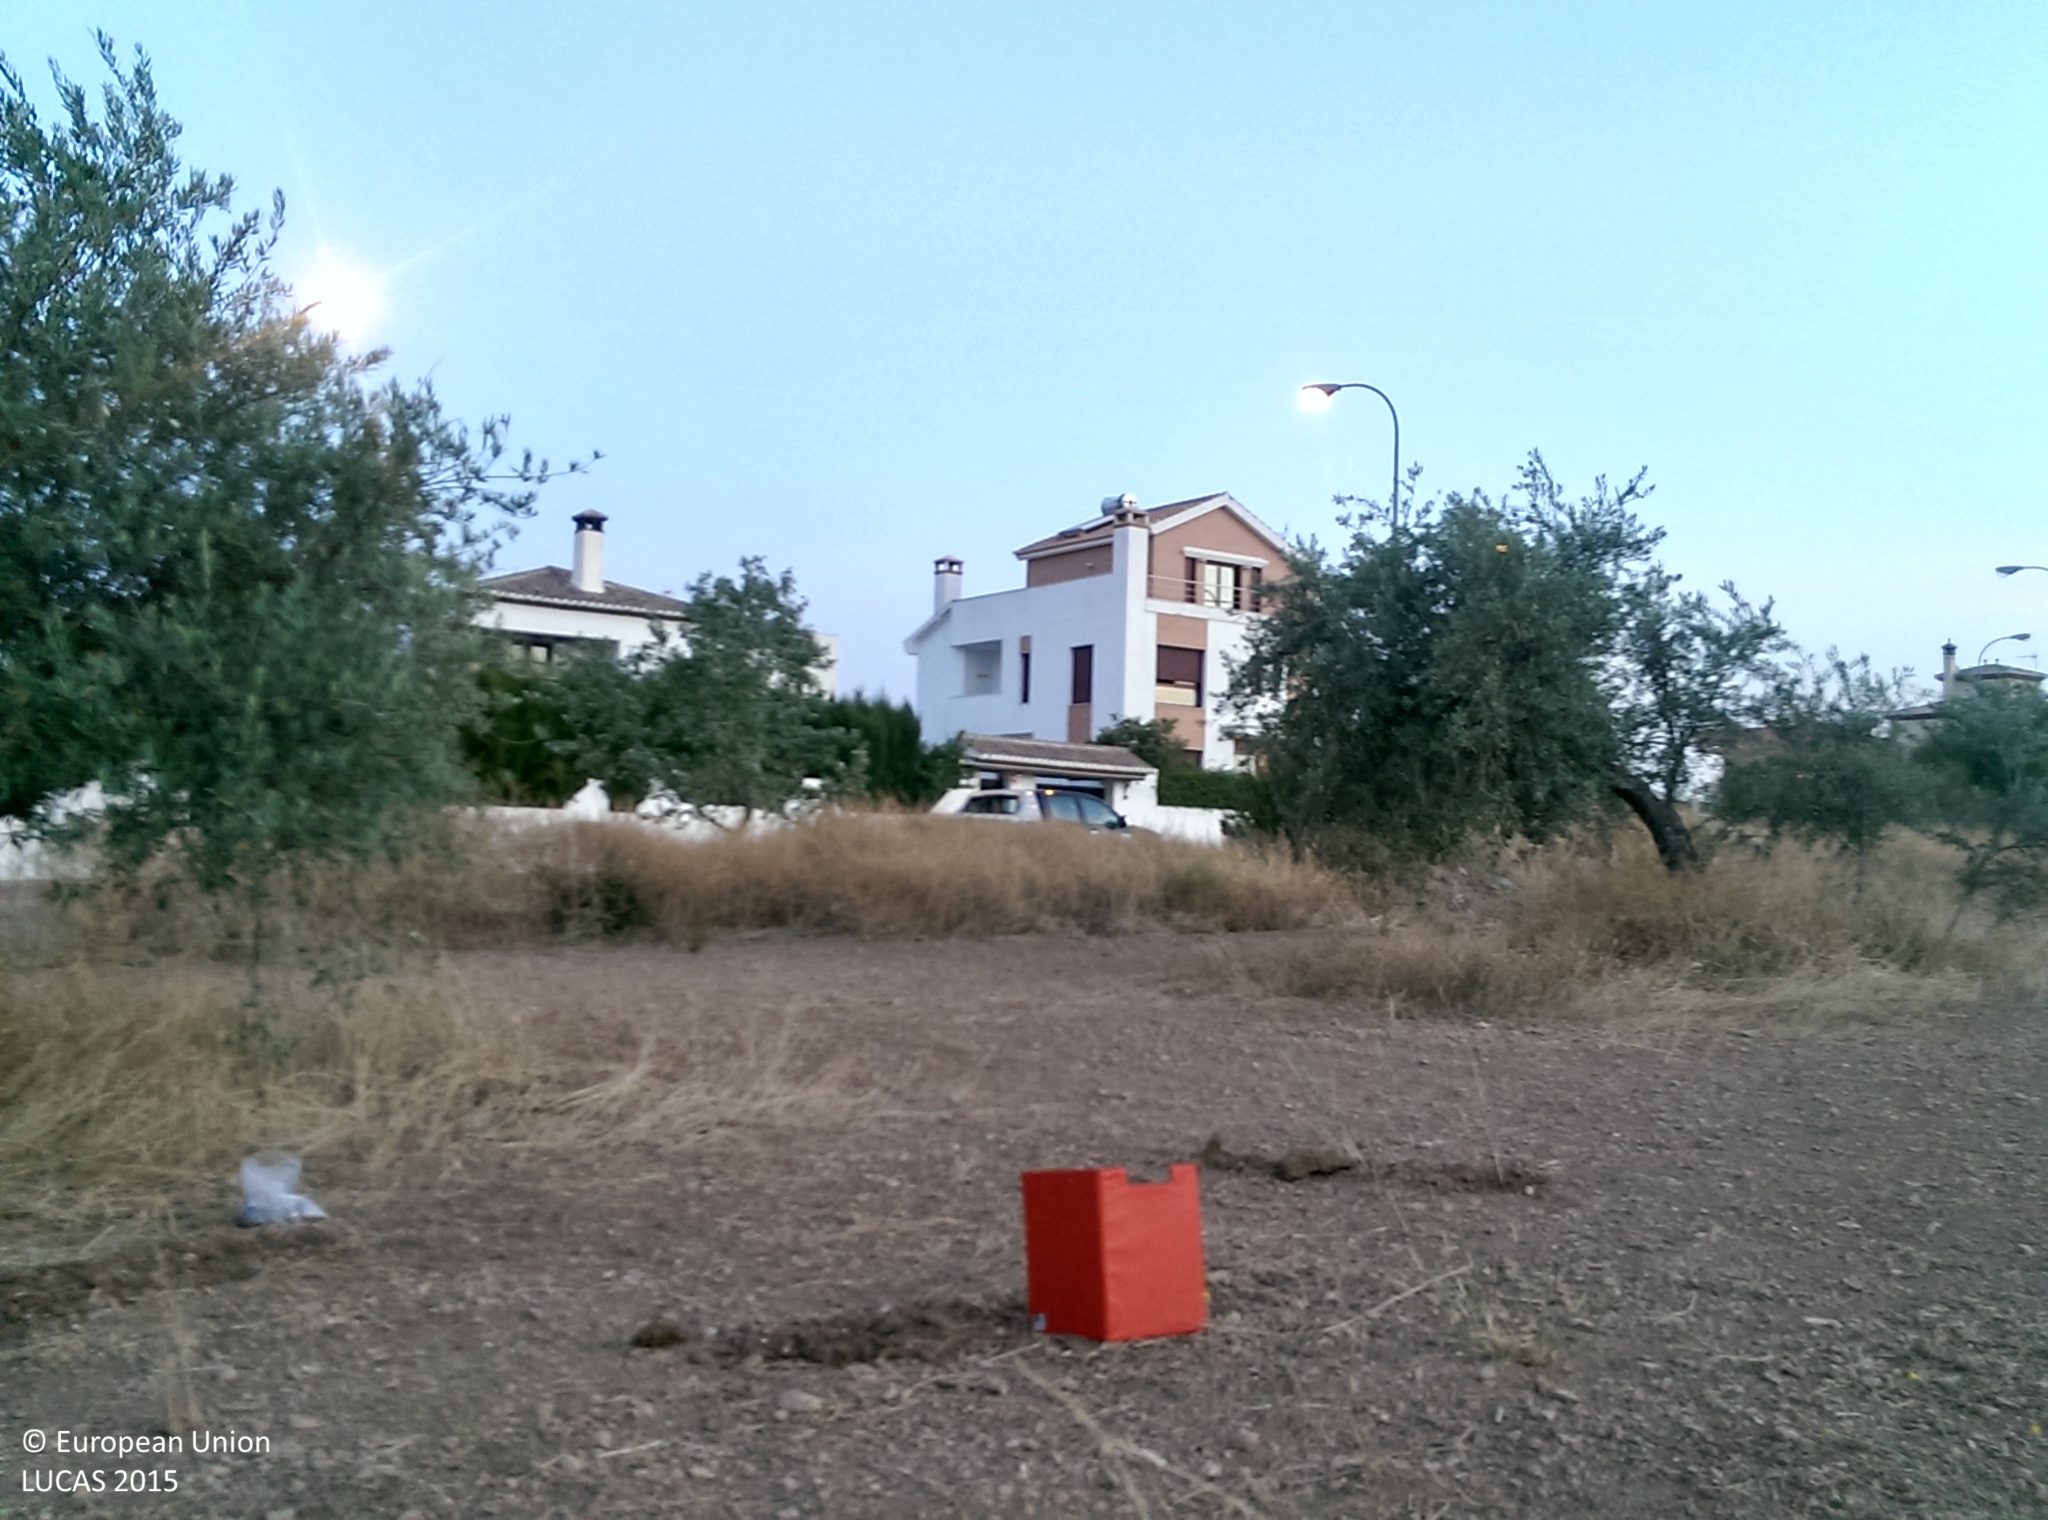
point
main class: Cropland
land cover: Olive groves
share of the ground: 10 - 25 %
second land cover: Other bare soil
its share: > 75 %
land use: Agriculture (excluding fallow land and kitchen gardens)
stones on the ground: 10 - 25 %
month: July
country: ES
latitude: 37.2873
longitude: -3.6739
